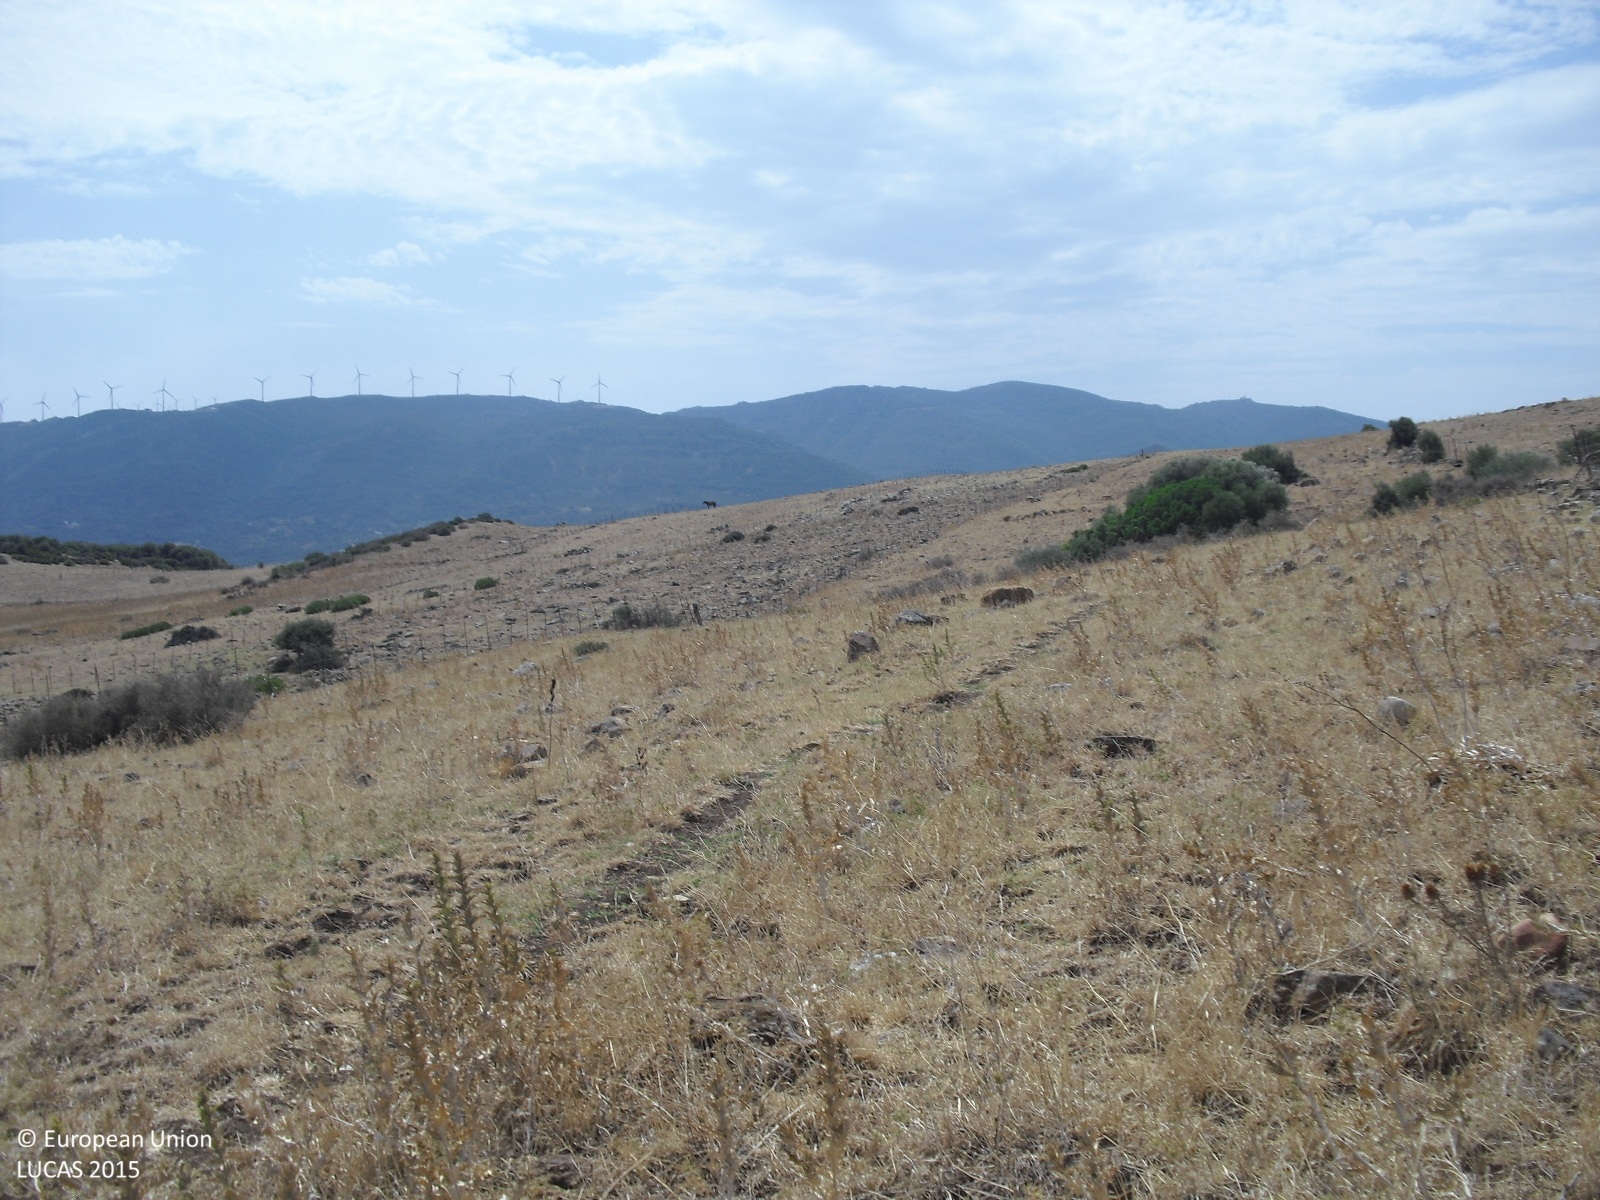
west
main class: Grassland
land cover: Grassland without tree/shrub cover
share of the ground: > 75 %
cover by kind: herbaceous plants 95 %, unconsolidated bare surface 5 %
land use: Agriculture (excluding fallow land and kitchen gardens)
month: July
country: ES
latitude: 36.1014
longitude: -5.5988
